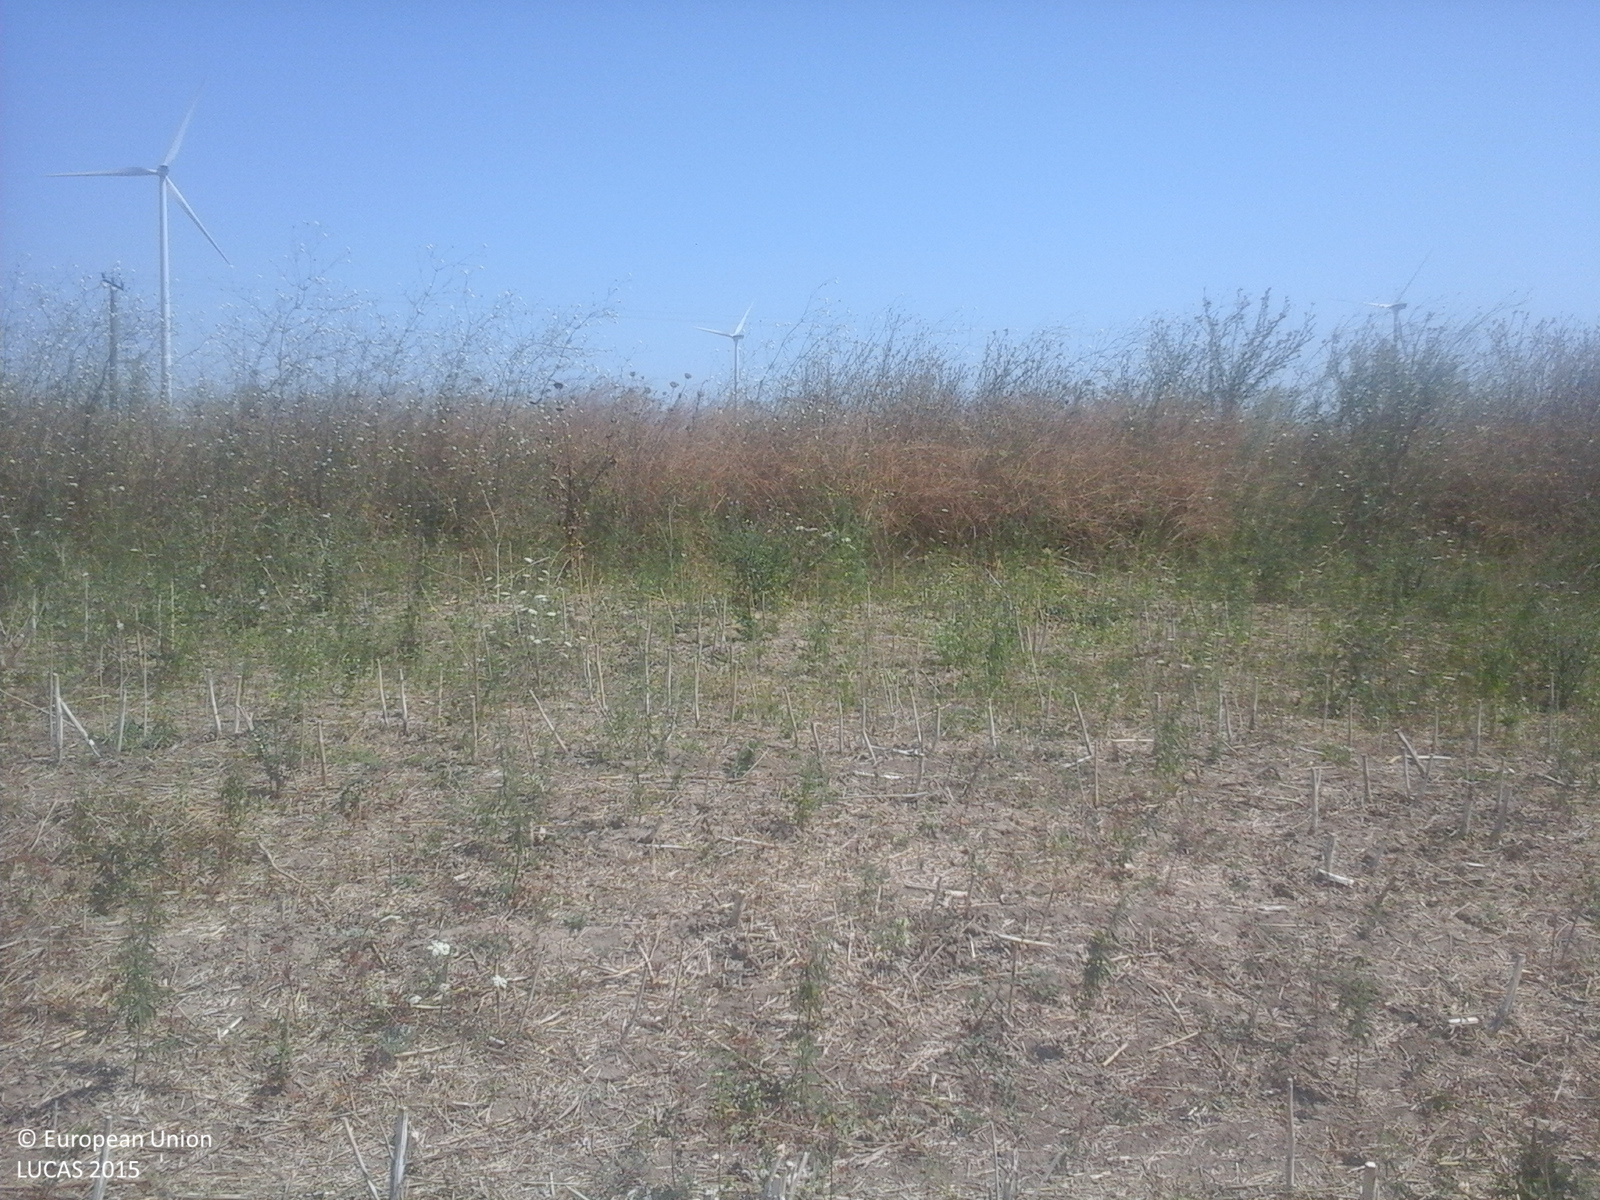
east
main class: Cropland
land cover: Rape and turnip rape
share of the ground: 50 - 75 %
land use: Agriculture (excluding fallow land and kitchen gardens)
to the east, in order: Rape and turnip rape; Ditches and canals; Common wheat; Electric lines; Common wheat; Lucerne
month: August
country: RO
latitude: 44.5157
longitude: 28.2956
